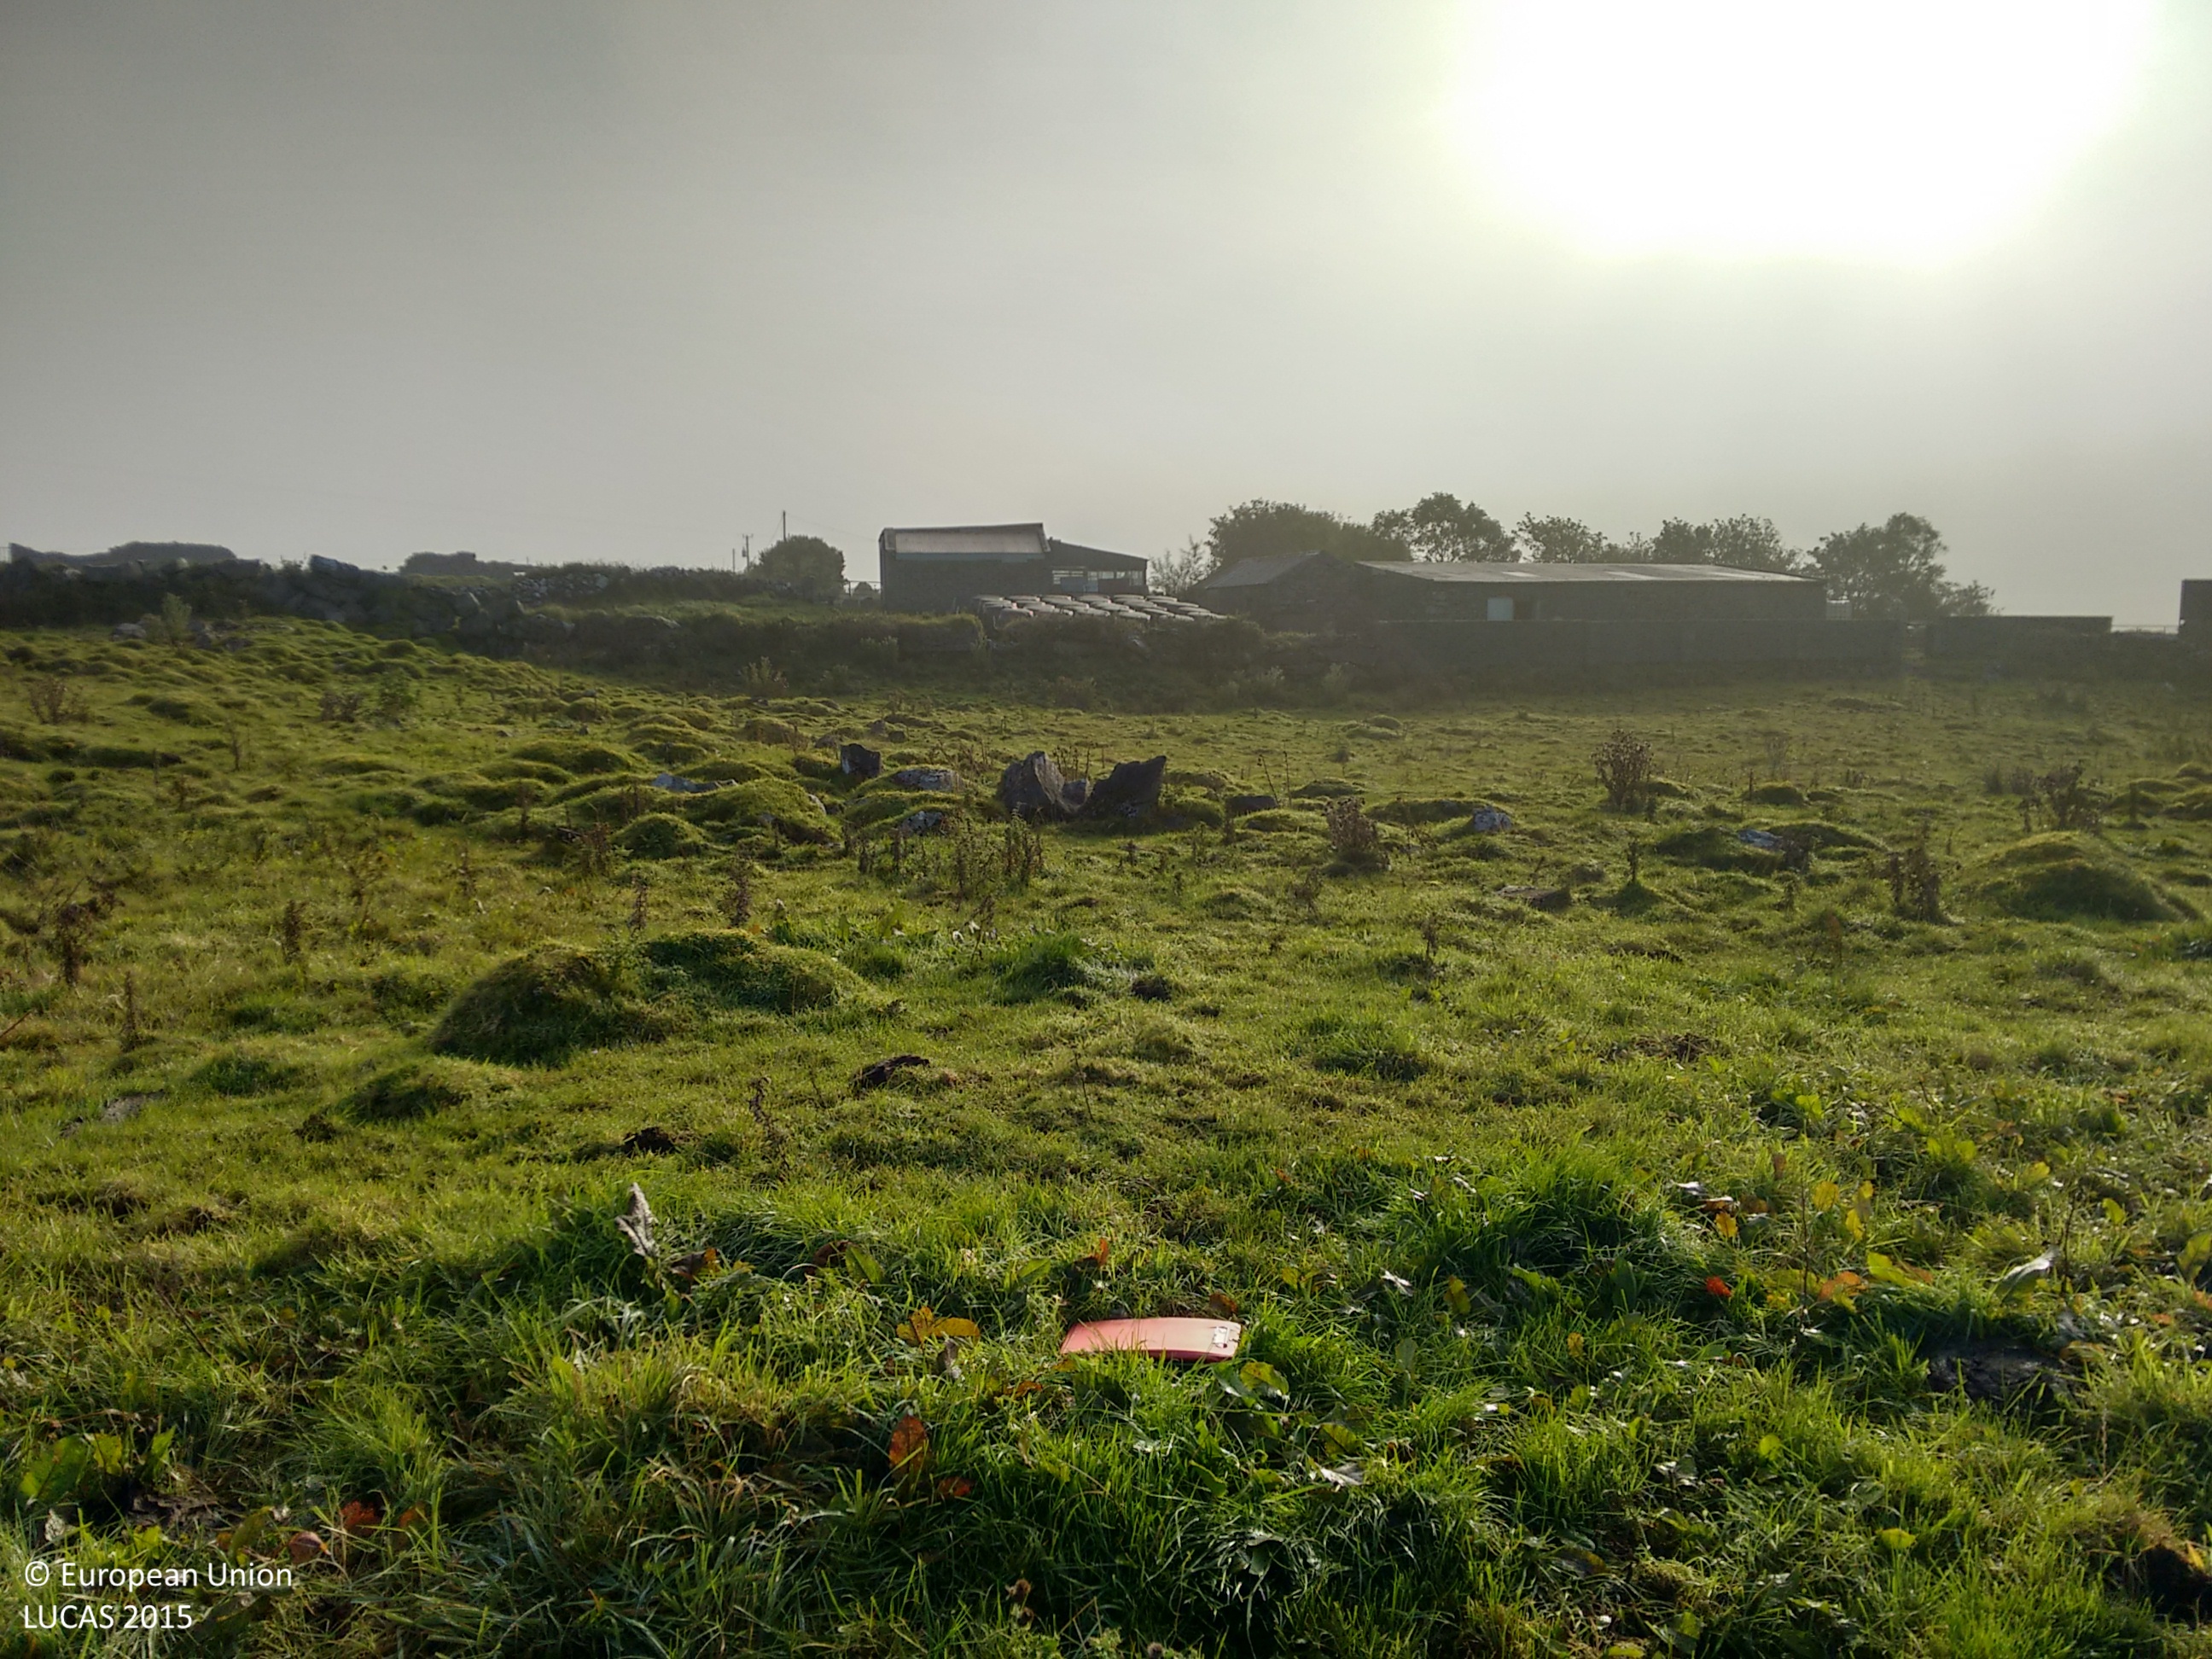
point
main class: Grassland
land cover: Grassland without tree/shrub cover
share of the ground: > 75 %
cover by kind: herbaceous plants 95 %, consolidated bare surface 5 %
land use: Agriculture (excluding fallow land and kitchen gardens)
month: September
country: IE
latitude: 53.0361
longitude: -9.2674
